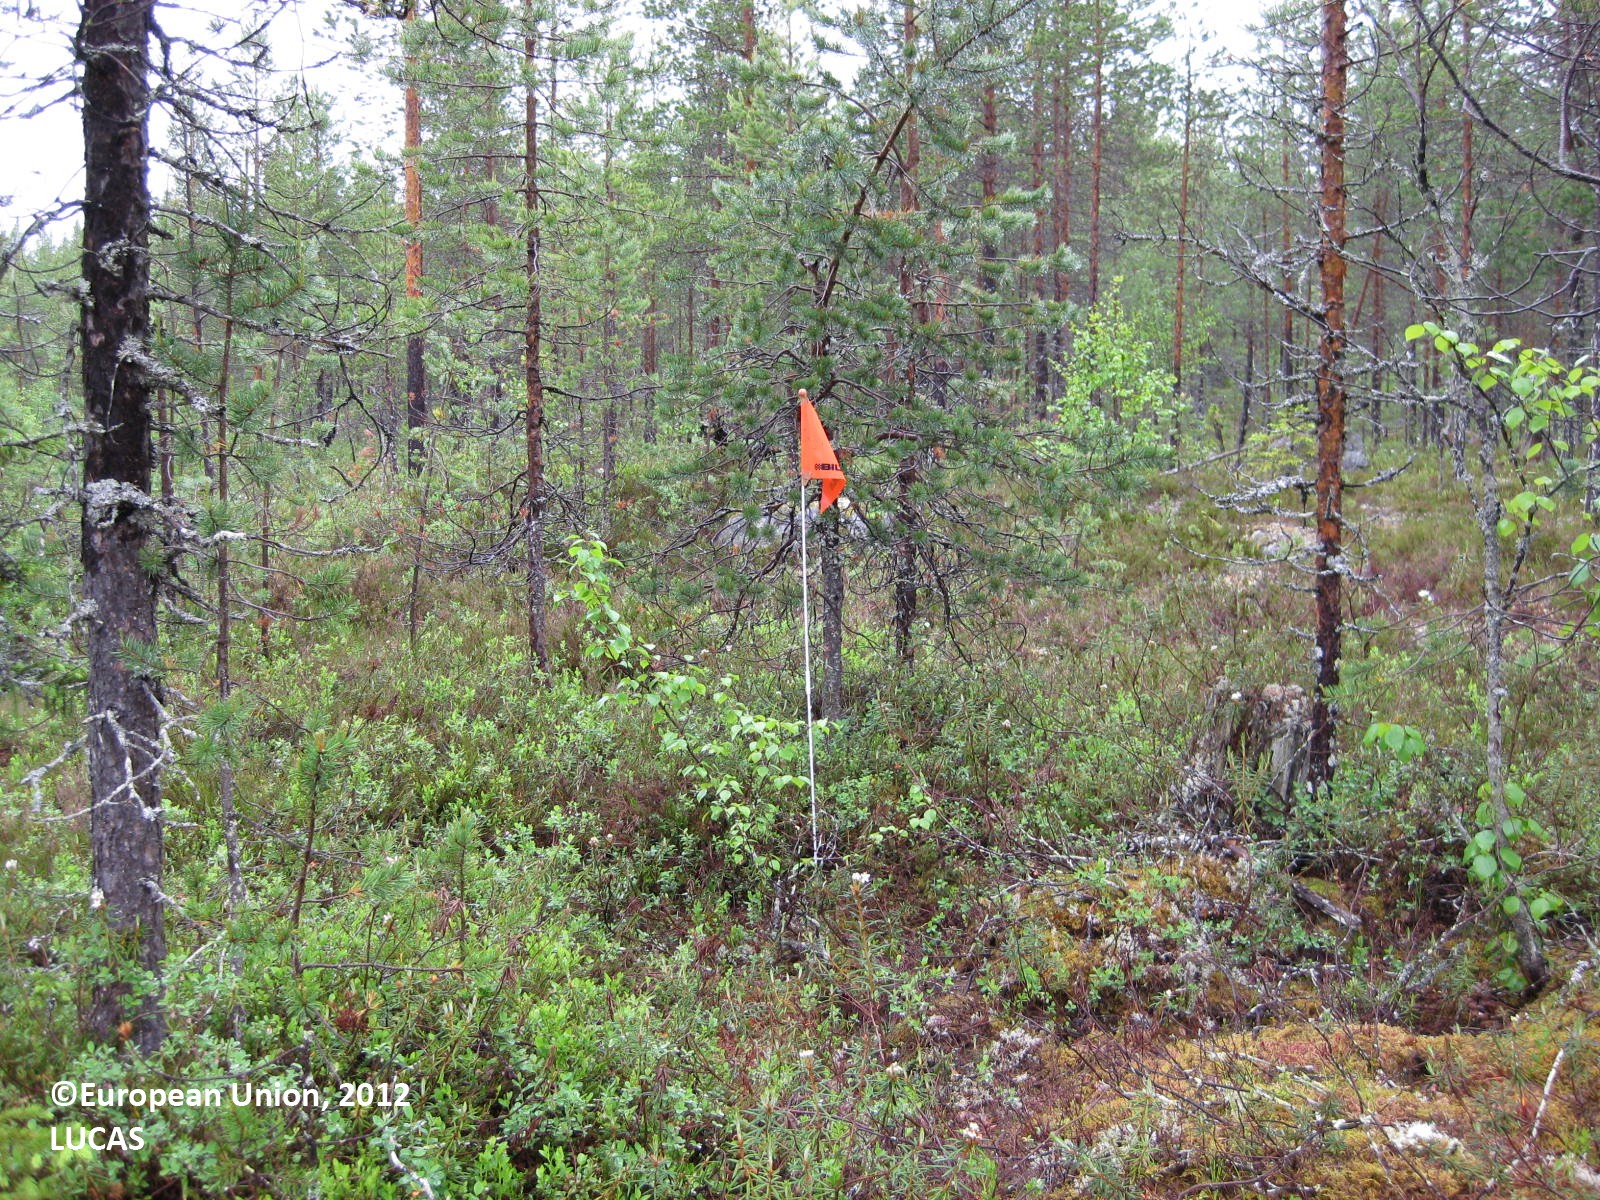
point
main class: Woodland
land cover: Pine dominated coniferous woodland
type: boreal forest
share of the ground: 50 - 75 %
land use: Forestry
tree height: > 5 m
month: June
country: FI
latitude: 65.3006
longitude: 29.3931
